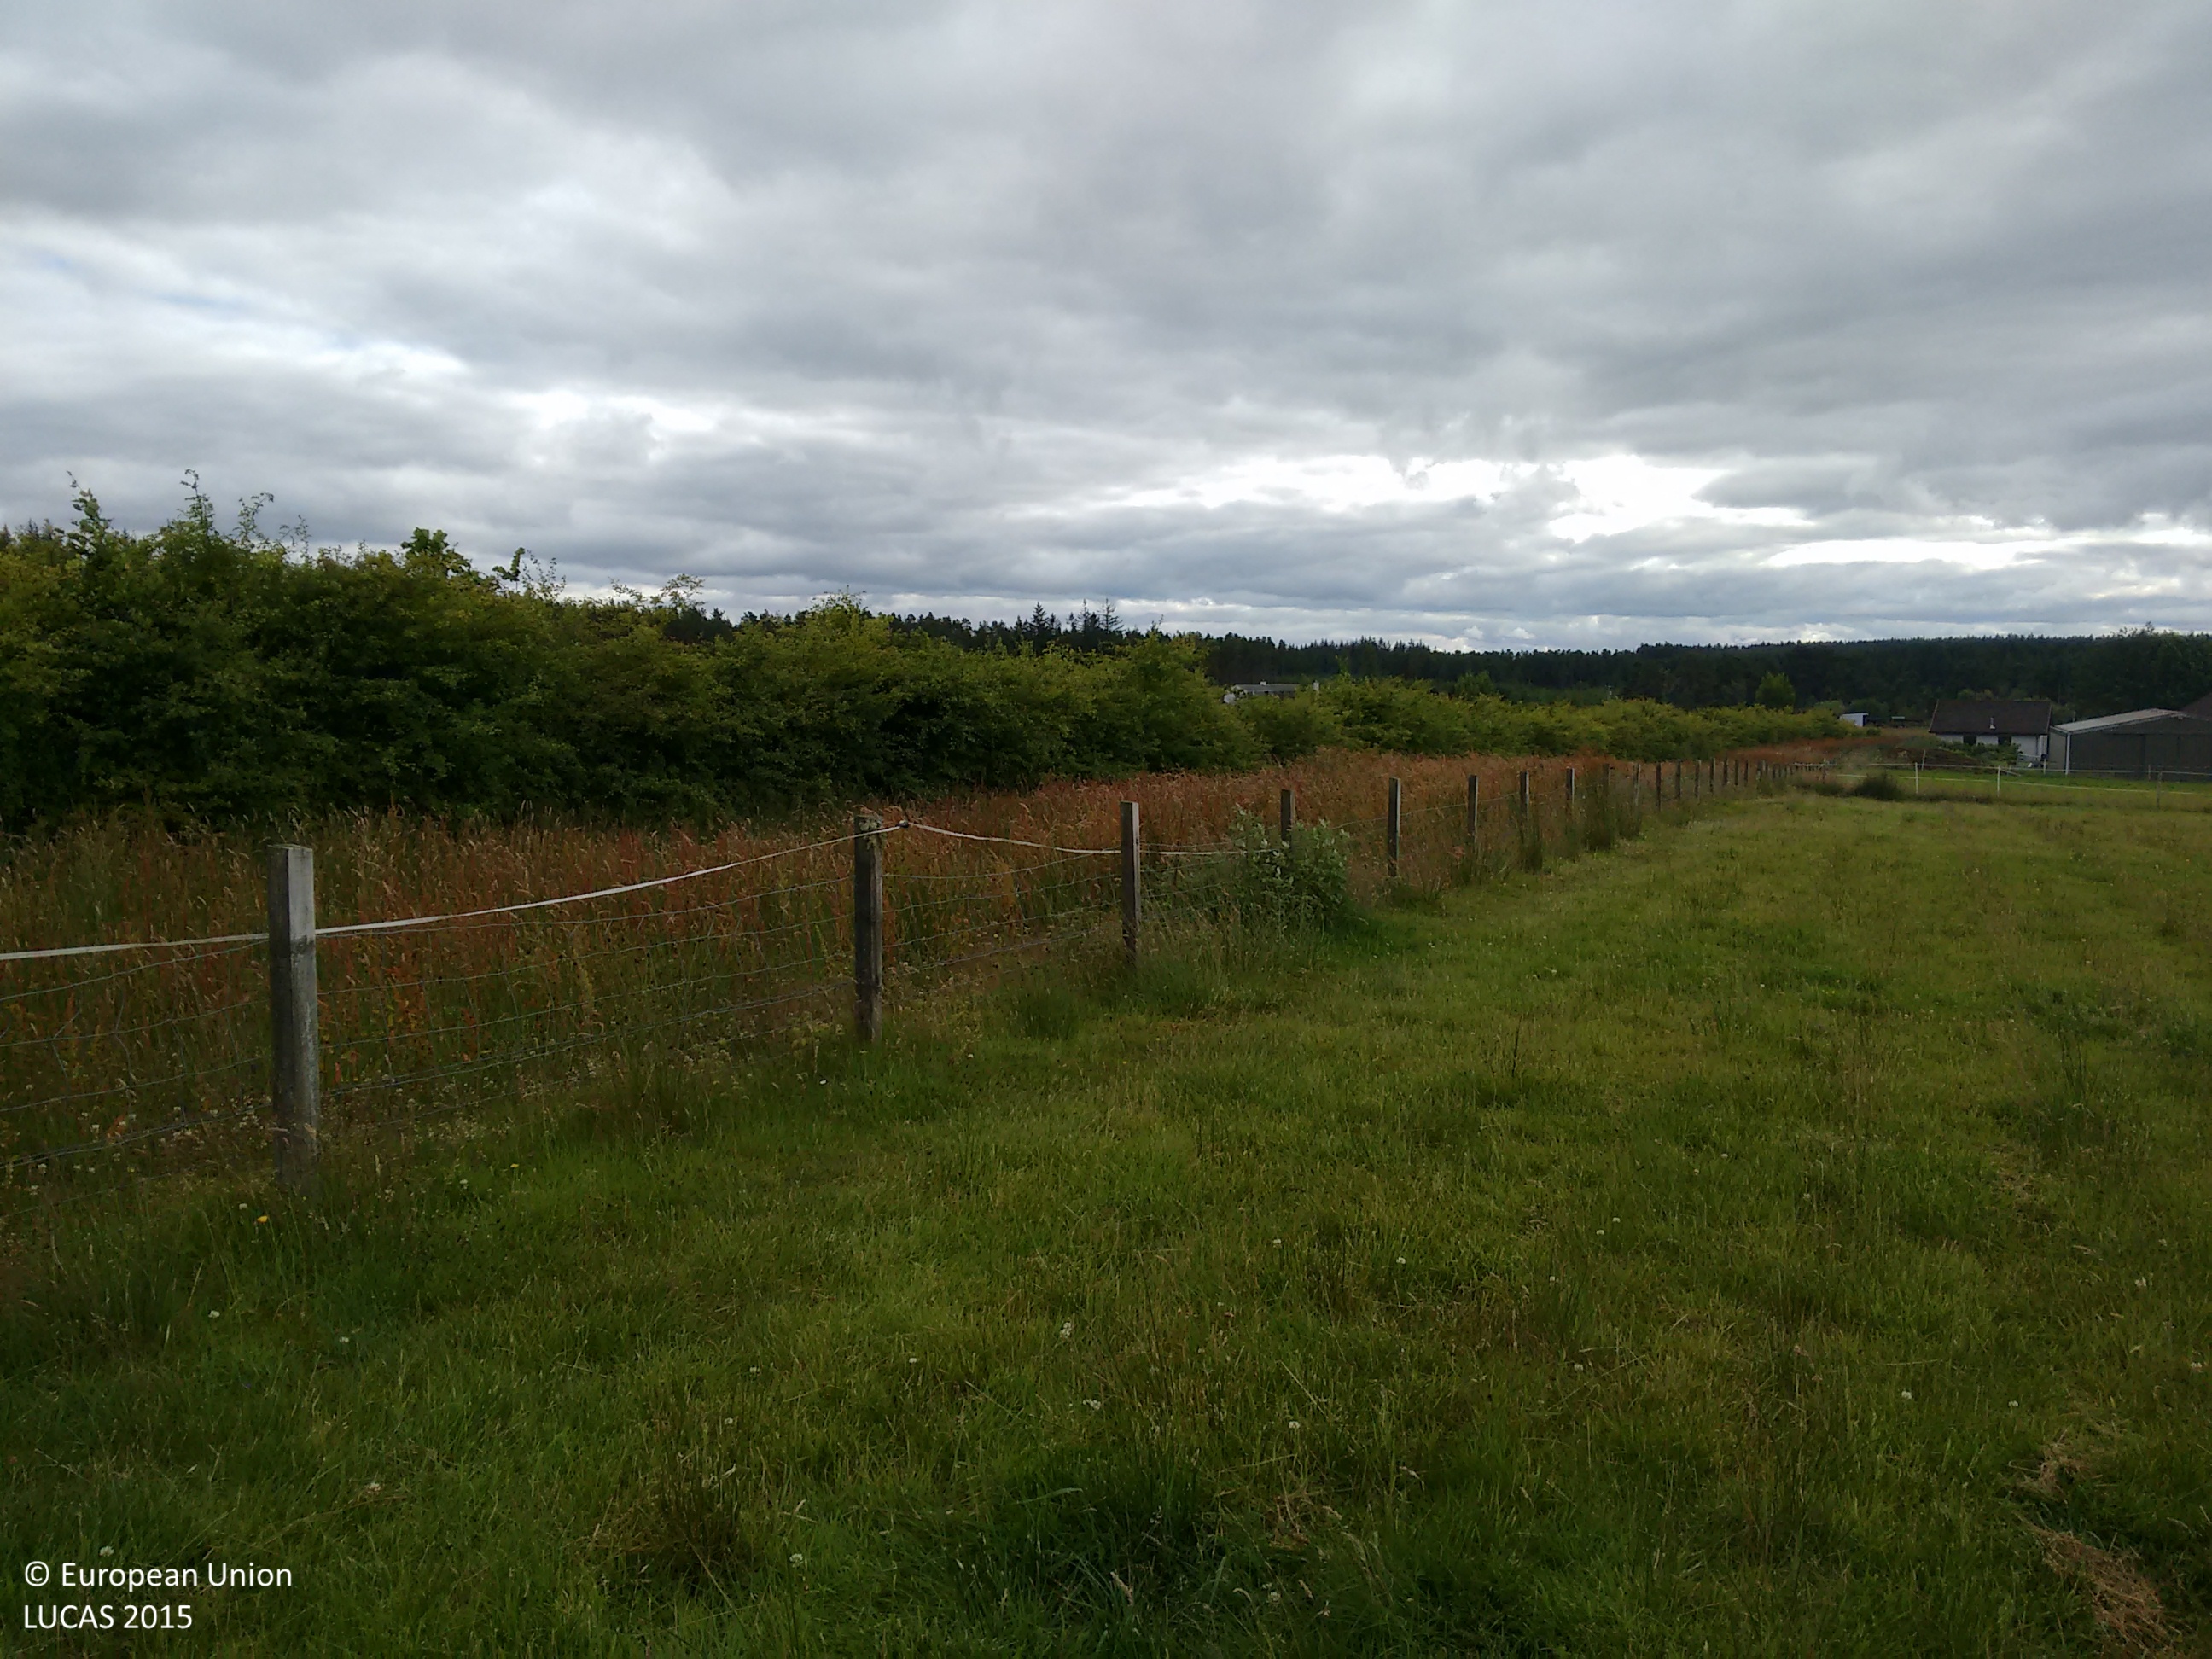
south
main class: Grassland
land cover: Grassland without tree/shrub cover
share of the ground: > 75 %
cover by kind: herbaceous plants 100 %
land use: Agriculture (excluding fallow land and kitchen gardens)
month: August
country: GB
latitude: 57.5966
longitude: -4.2909
